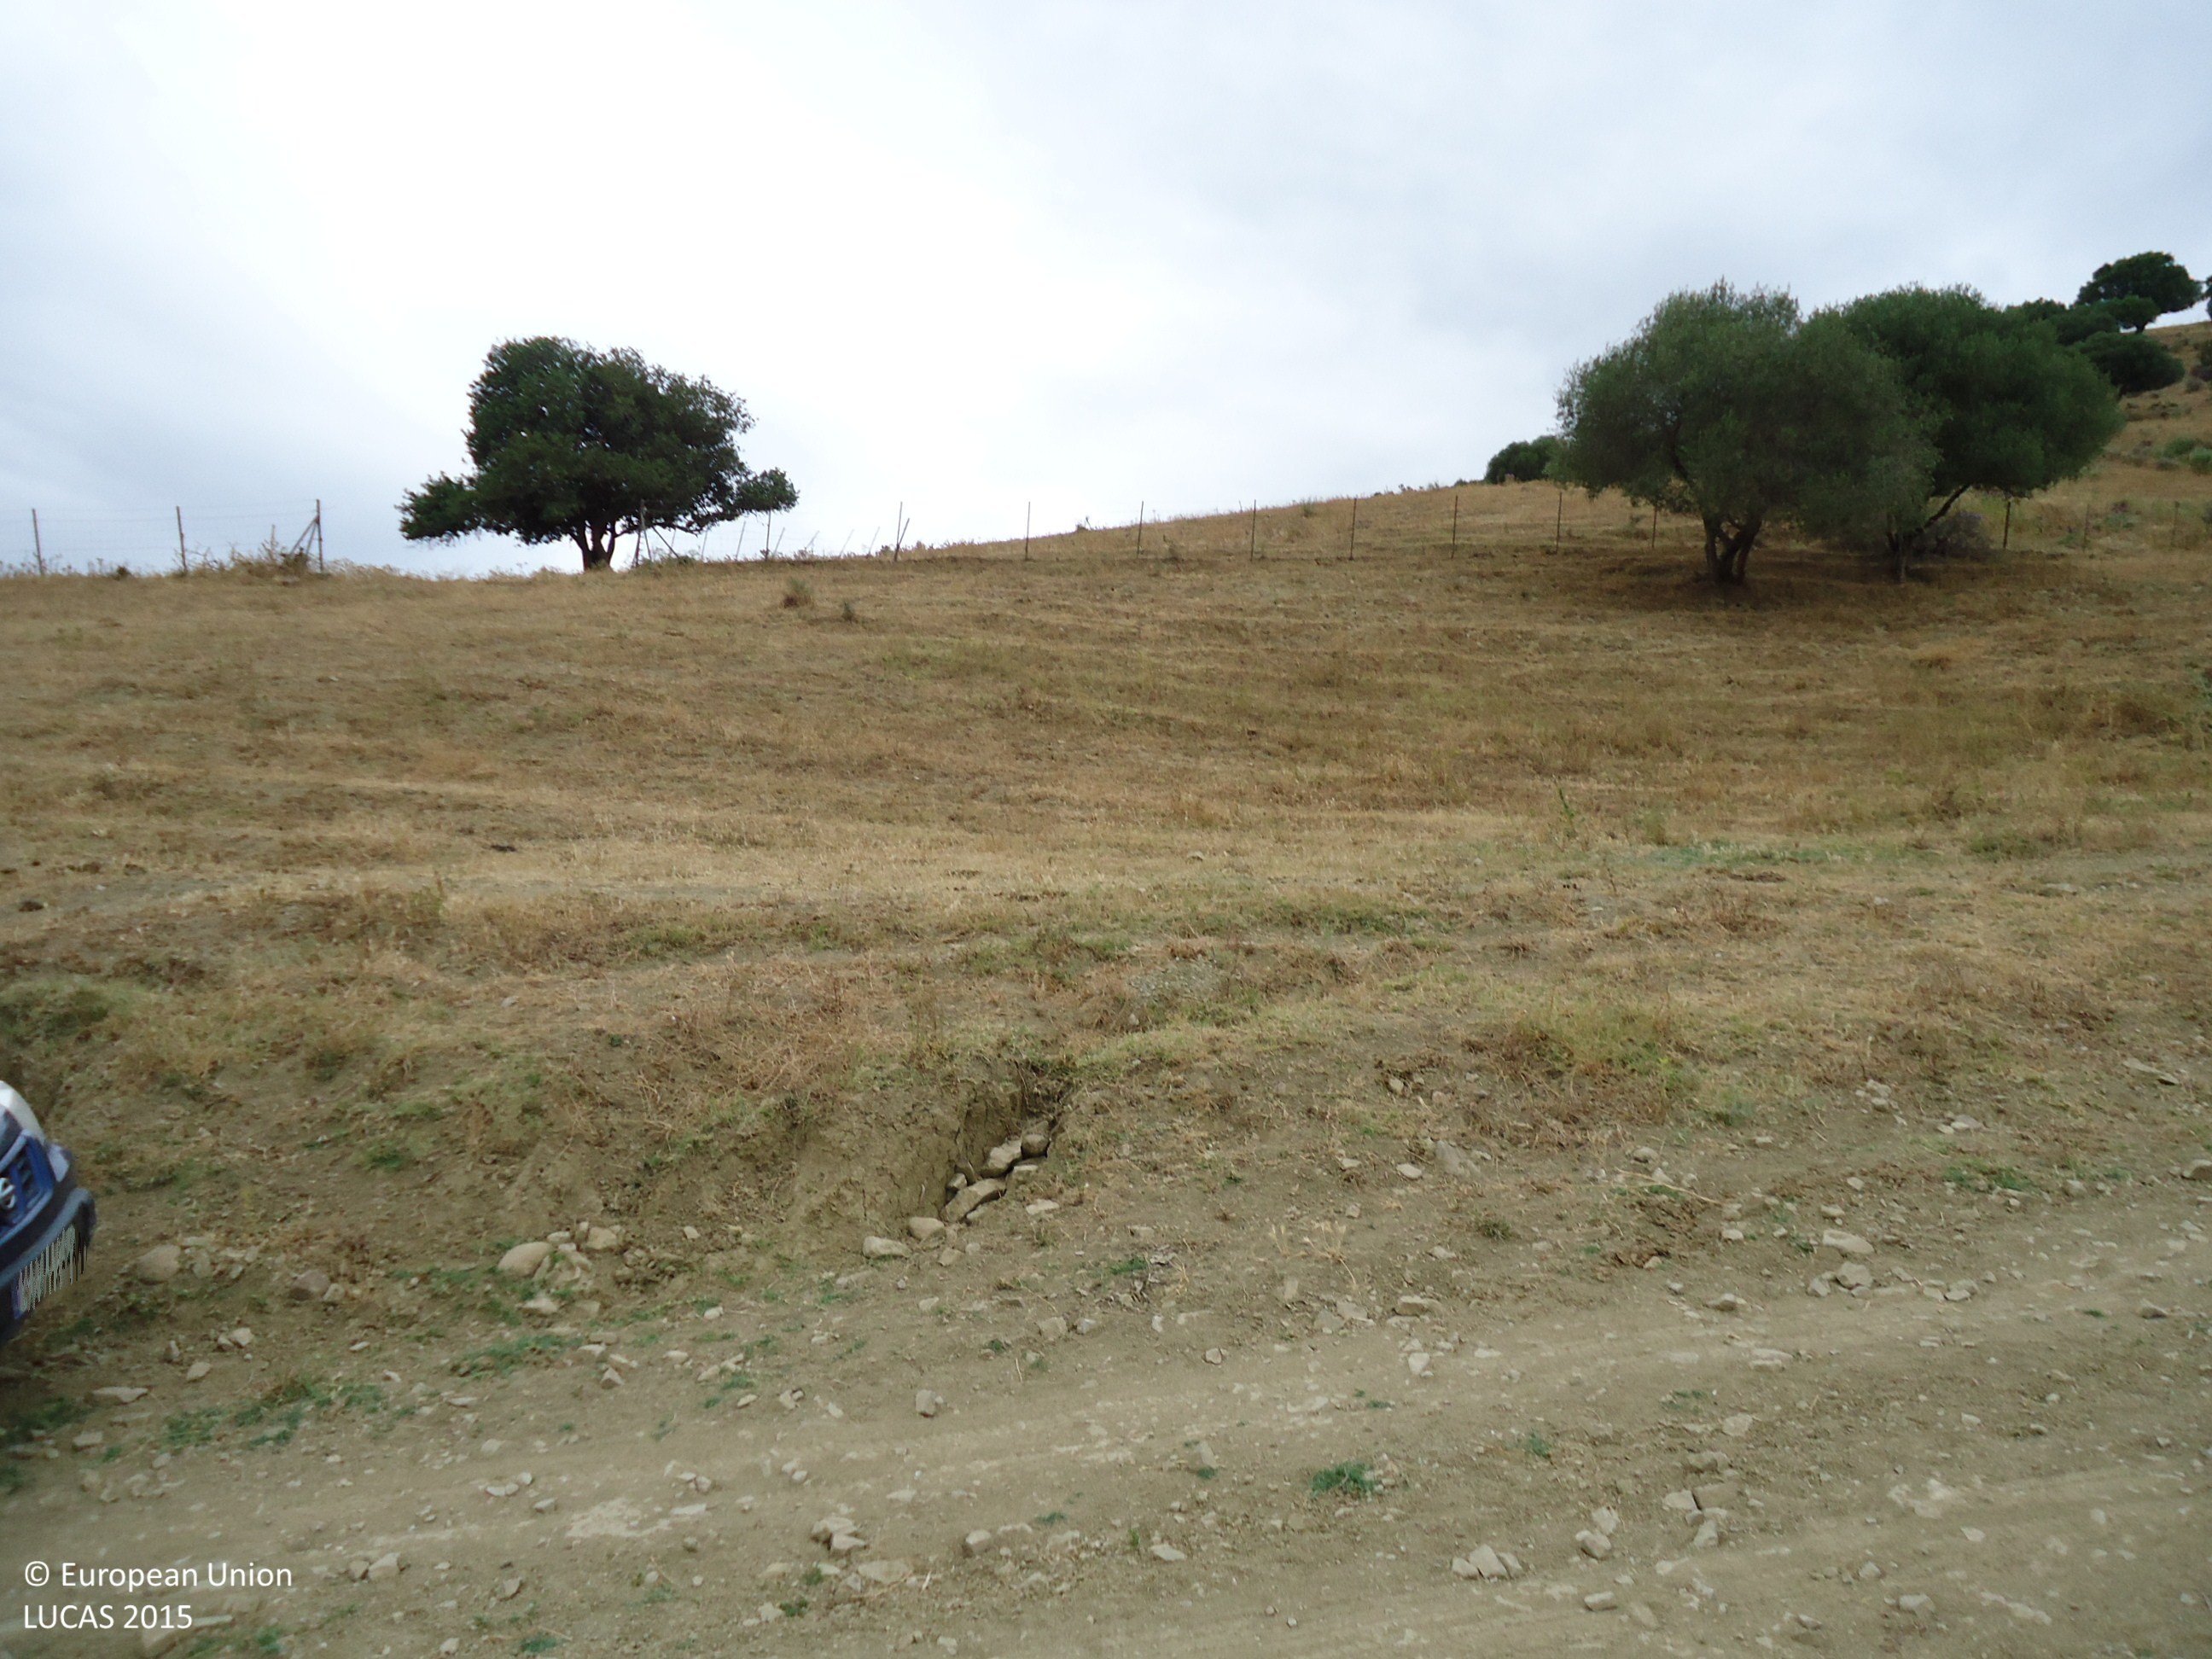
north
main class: Cropland
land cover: Barley
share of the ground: > 75 %
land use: Agriculture (excluding fallow land and kitchen gardens)
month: June
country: ES
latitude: 36.4154
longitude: -5.3747
